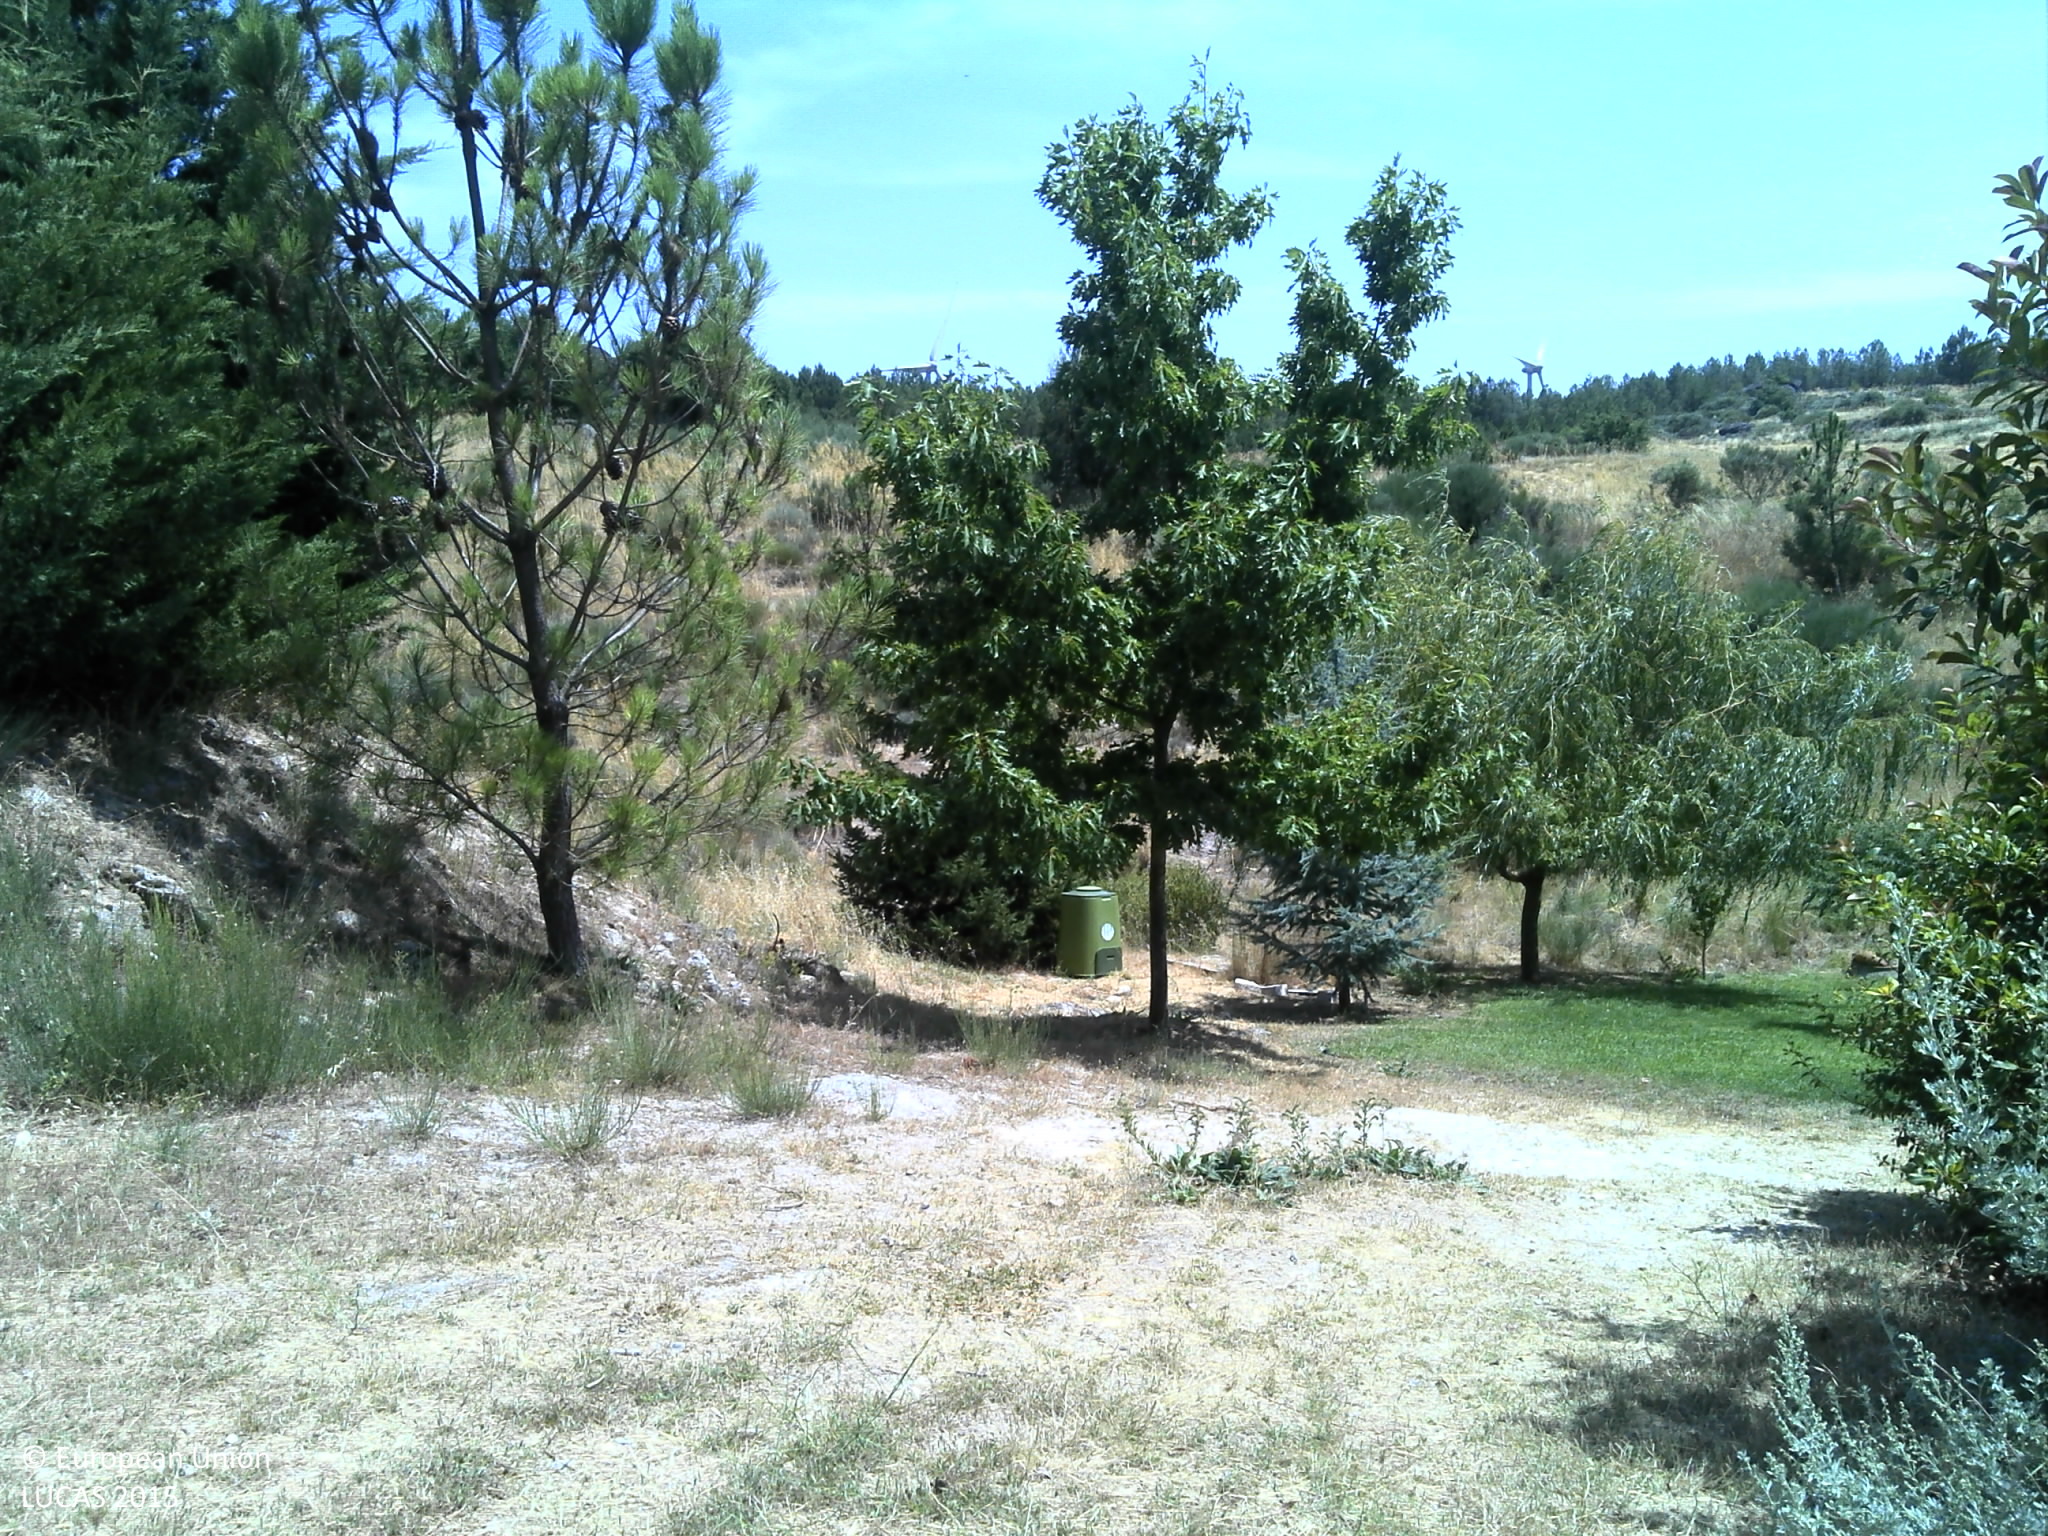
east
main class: Grassland
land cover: Grassland without tree/shrub cover
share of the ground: 50 - 75 %
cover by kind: herbaceous plants 50 %, unconsolidated bare surface 35 %, consolidated bare surface 10 %, shrubs 5 %
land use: Residential
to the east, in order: Grassland without tree/shrub cover; Abandoned hedges; Shrubland with sparse tree cover; Shrubland without tree cover; Tracks; Shrubland without tree cover; Shrubland with sparse tree cover; Grassland with sparse tree/shrub cover; Tracks; Other bare soil; Shruby margins; Ditches and canals; Shrubland without tree cover; Rocks and stones; Shrubland with sparse tree cover
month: July
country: PT
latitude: 40.8094
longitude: -7.3608
